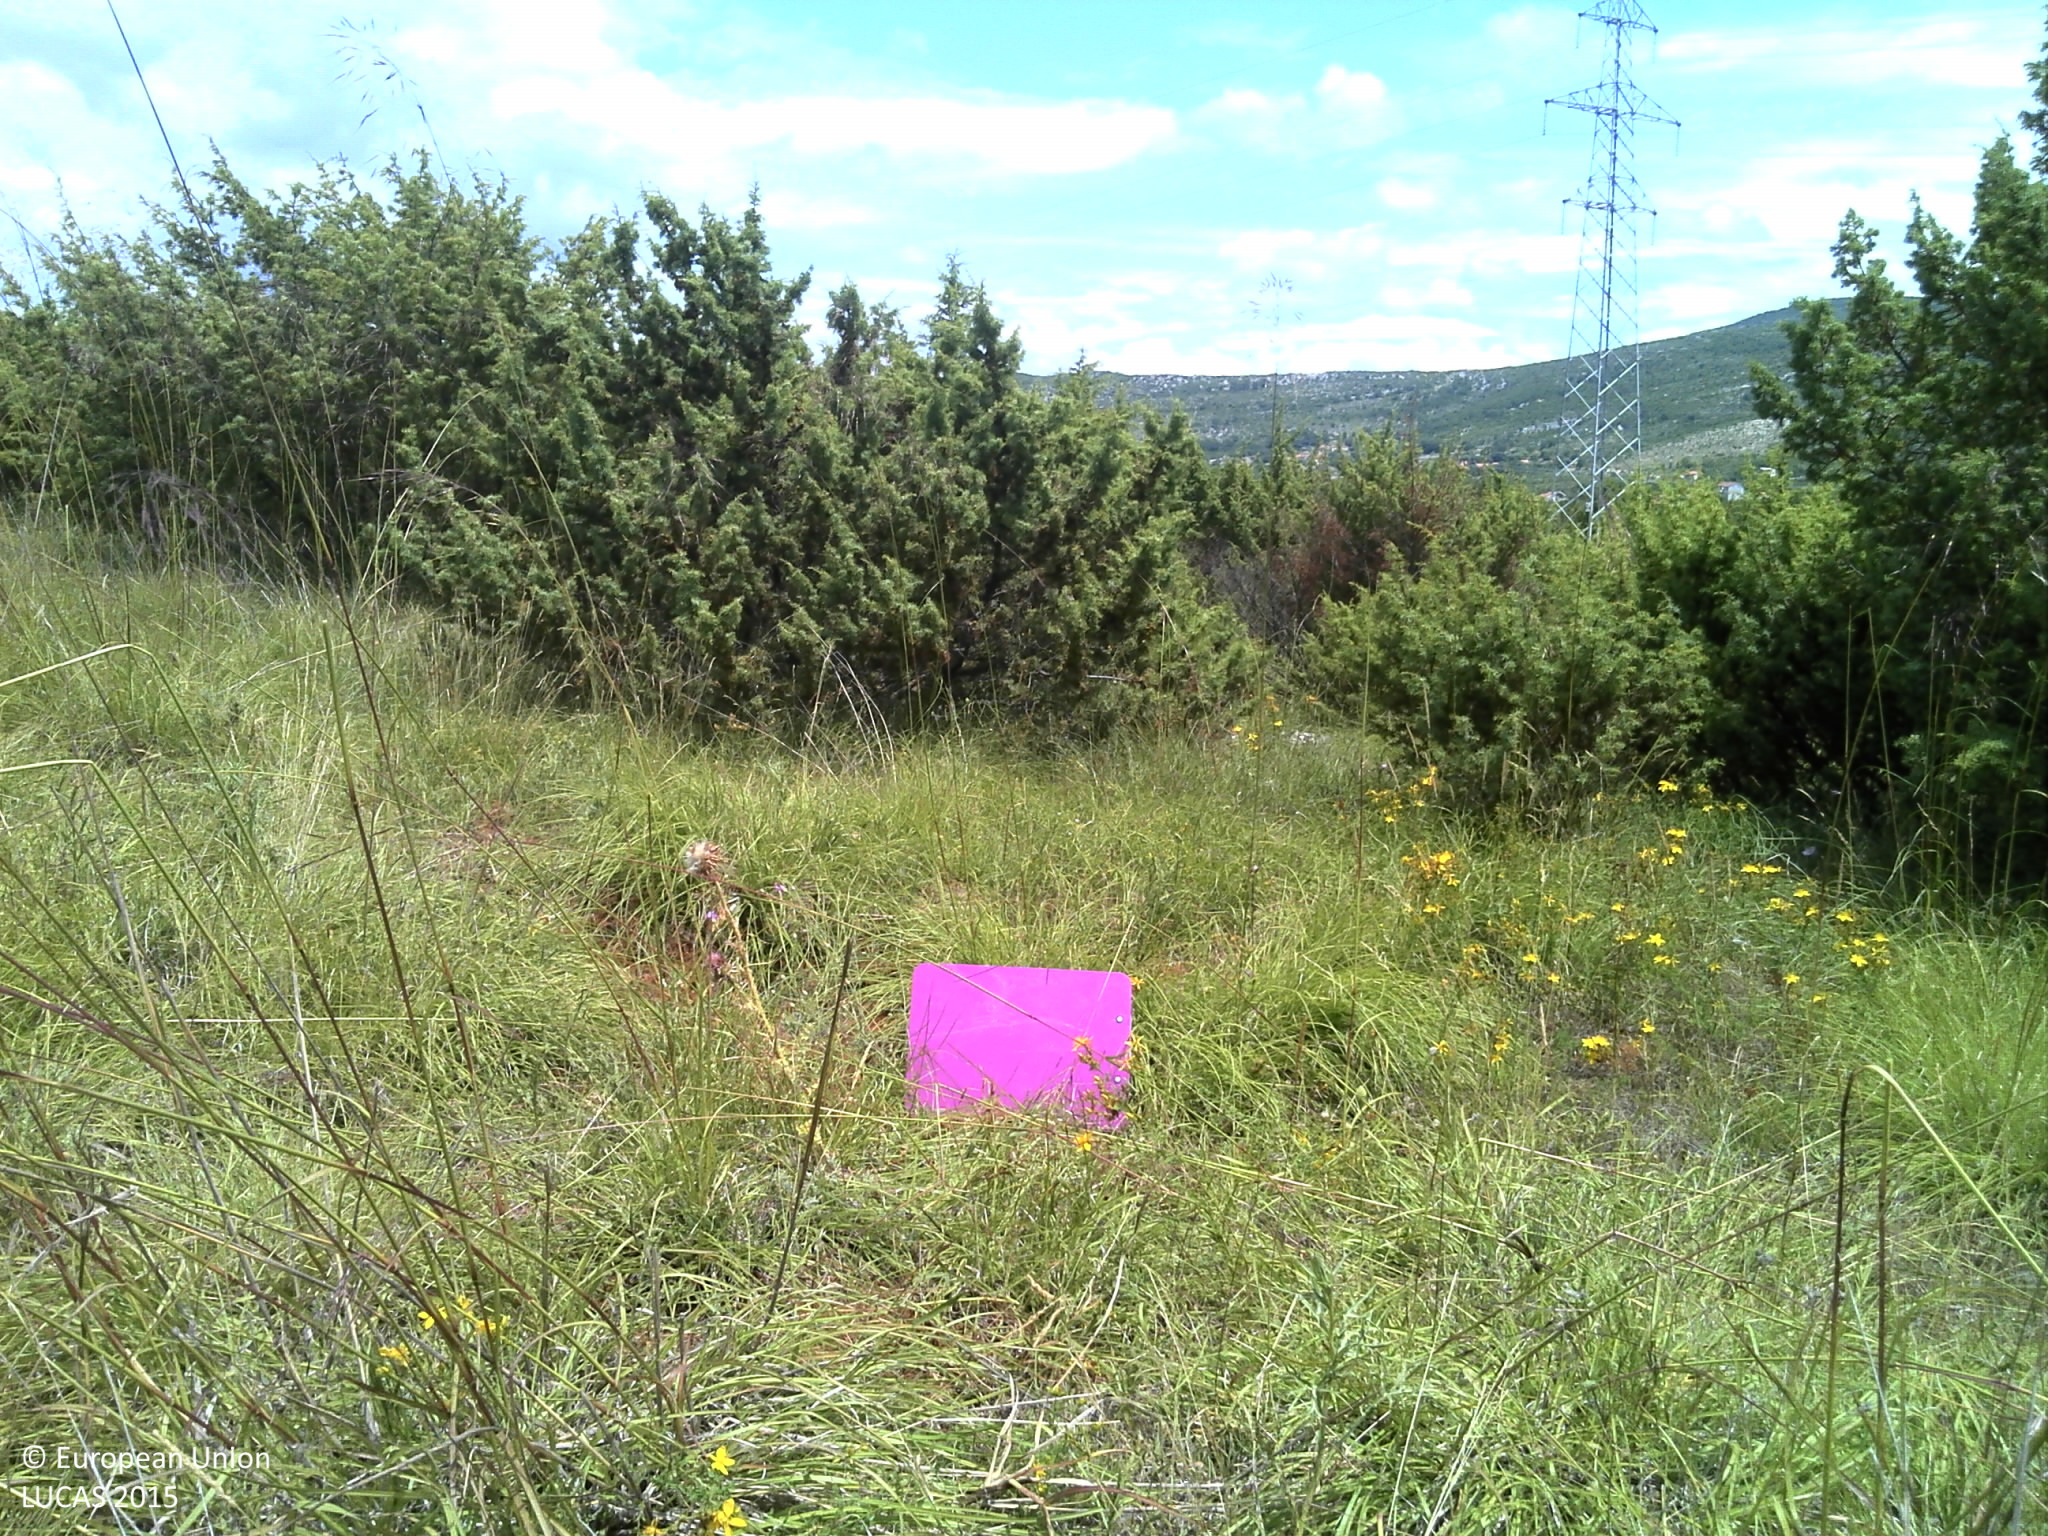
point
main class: Shrubland
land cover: Shrubland with sparse tree cover
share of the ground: 50 - 75 %
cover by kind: herbaceous plants 50 %, shrubs 35 %, coniferous forest trees 5 %, consolidated bare surface 5 %, unconsolidated bare surface 5 %
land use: Semi-natural and natural areas not in use
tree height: < 5 m
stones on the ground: < 10 %
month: June
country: HR
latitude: 43.6042
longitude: 16.4954
